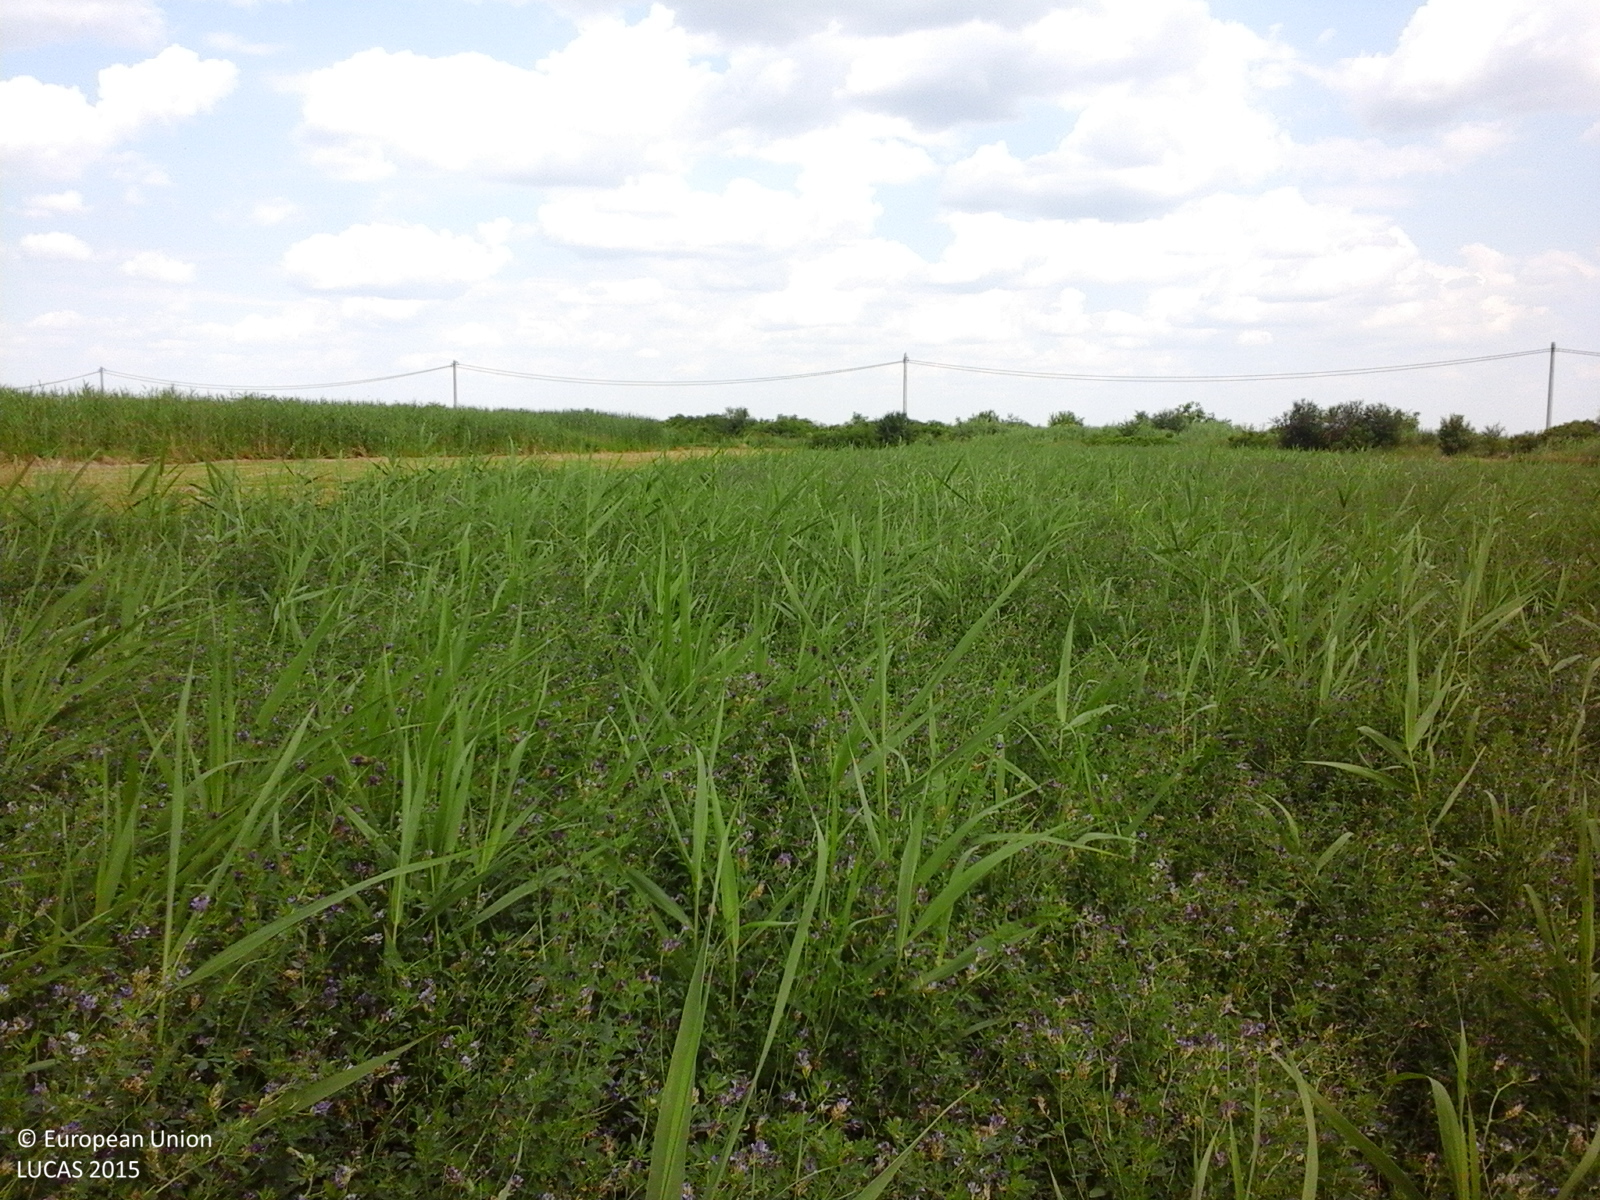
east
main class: Cropland
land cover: Lucerne
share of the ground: > 75 %
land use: Agriculture (excluding fallow land and kitchen gardens)
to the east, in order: Lucerne; Tracks; Shrubland with sparse tree cover; Tracks; Shrubland with sparse tree cover; Electric lines; Spontaneously vegetated surfaces; Abandoned hedges; Permanent crops (only in case pi)
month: June
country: RO
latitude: 44.2220
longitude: 26.2159
